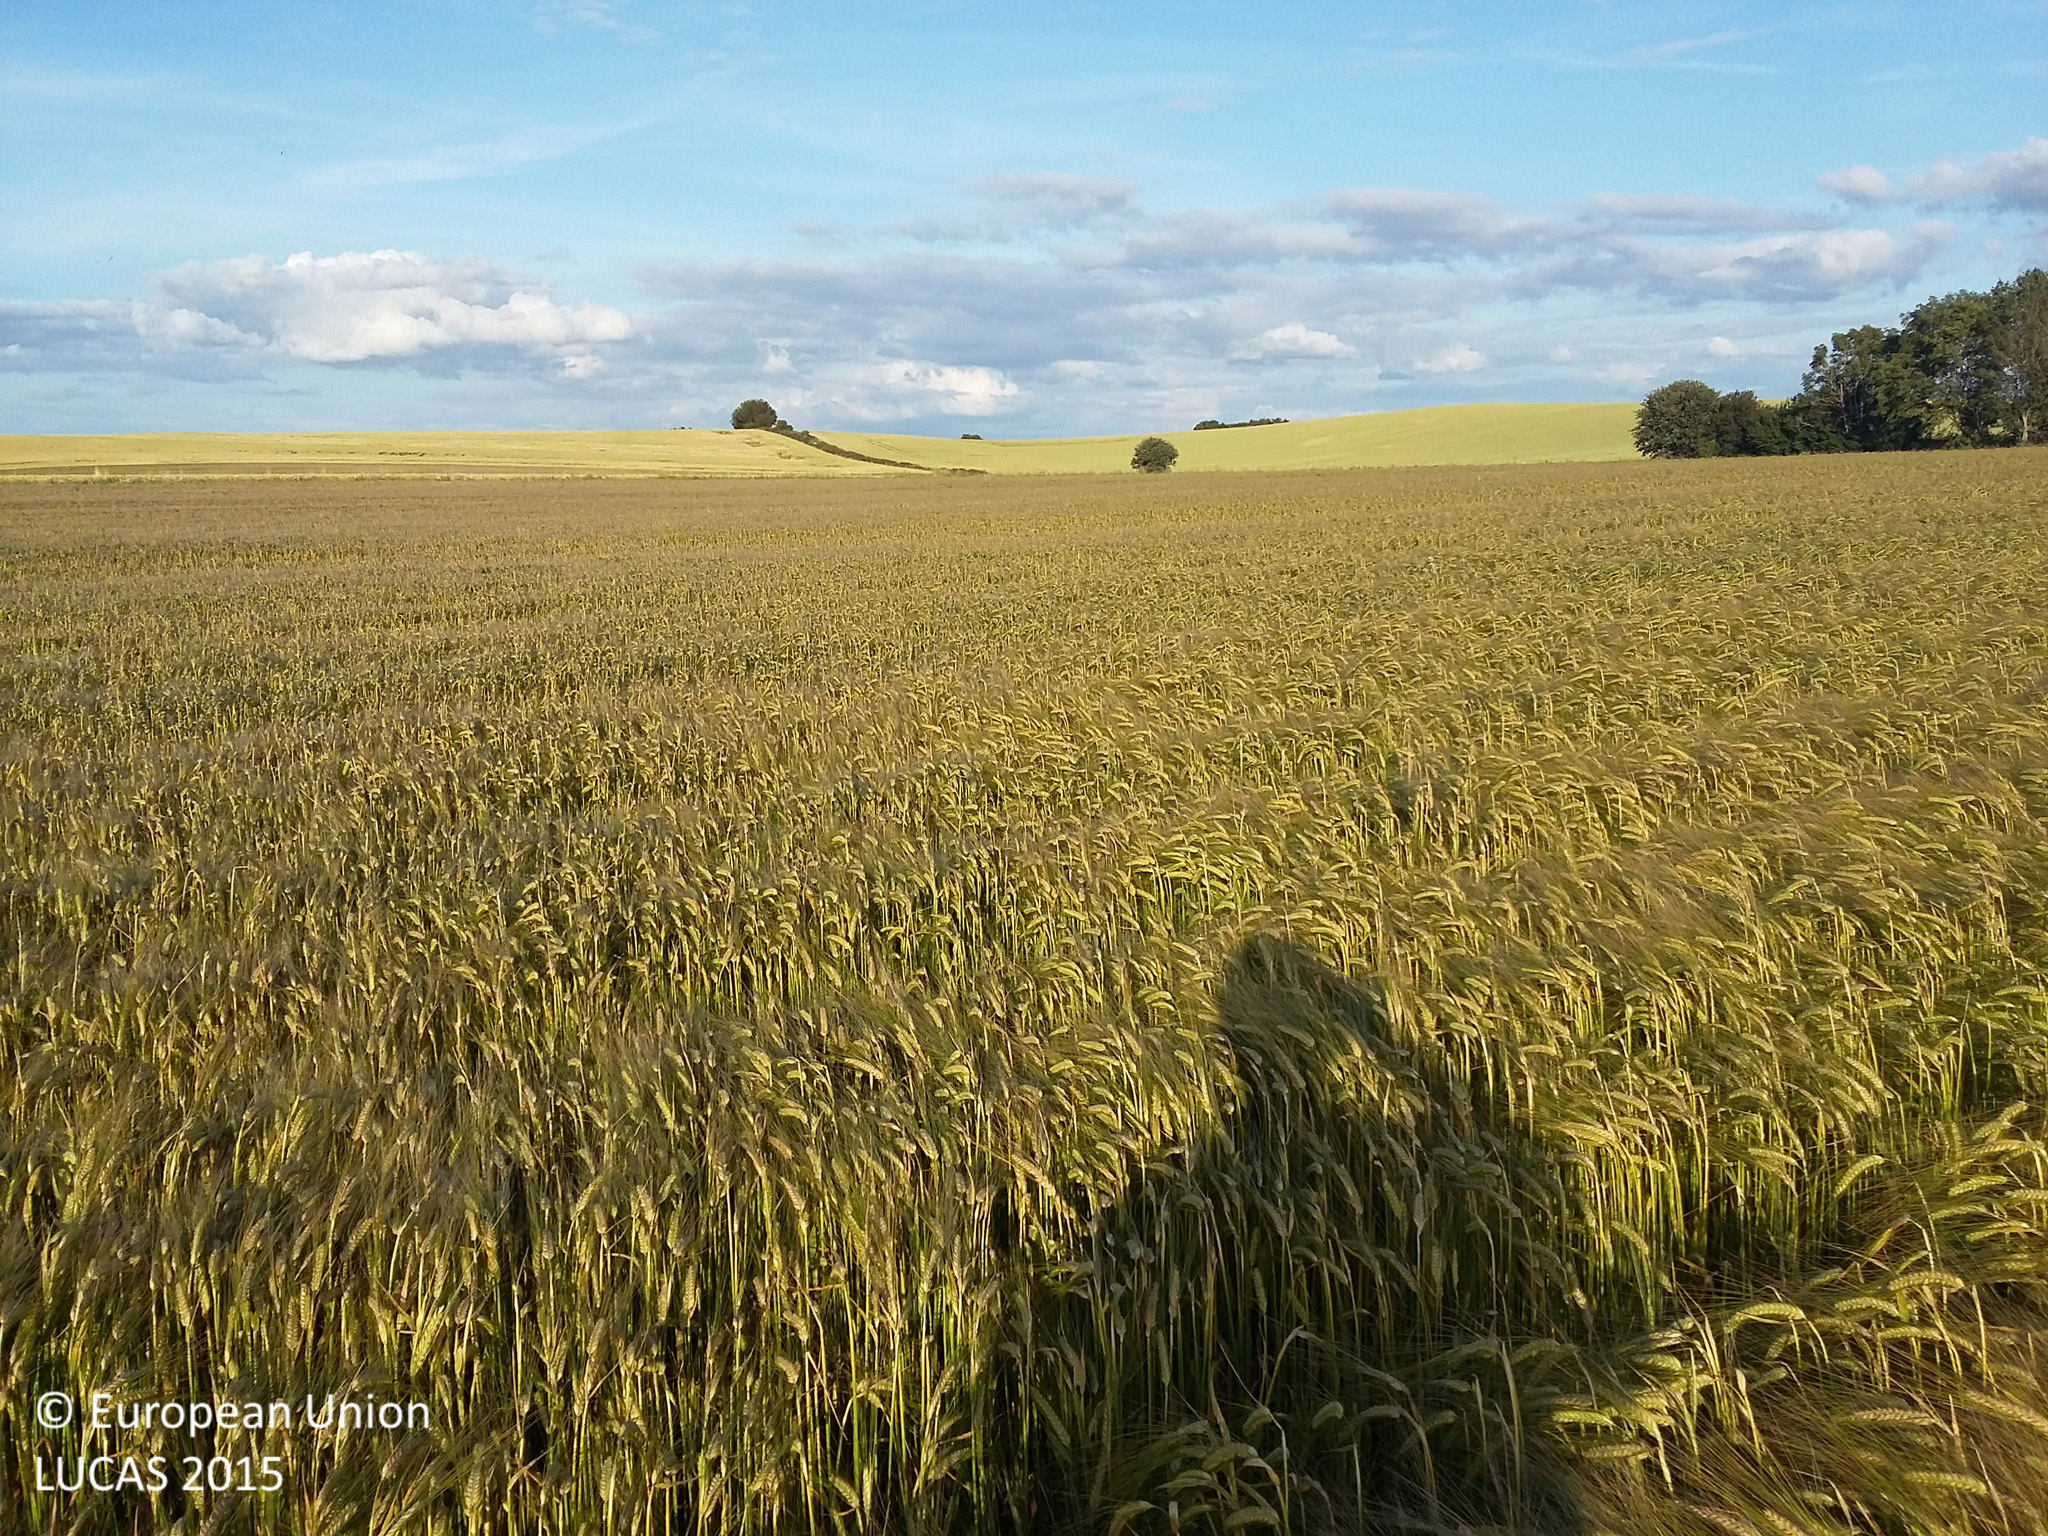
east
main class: Cropland
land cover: Barley
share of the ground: > 75 %
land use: Agriculture (excluding fallow land and kitchen gardens)
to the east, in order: Barley; Grass margins; Paved roads, cycling and walking lanes; Grass margins; Common wheat; Barley
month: July
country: DK
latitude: 55.7485
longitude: 11.4165
